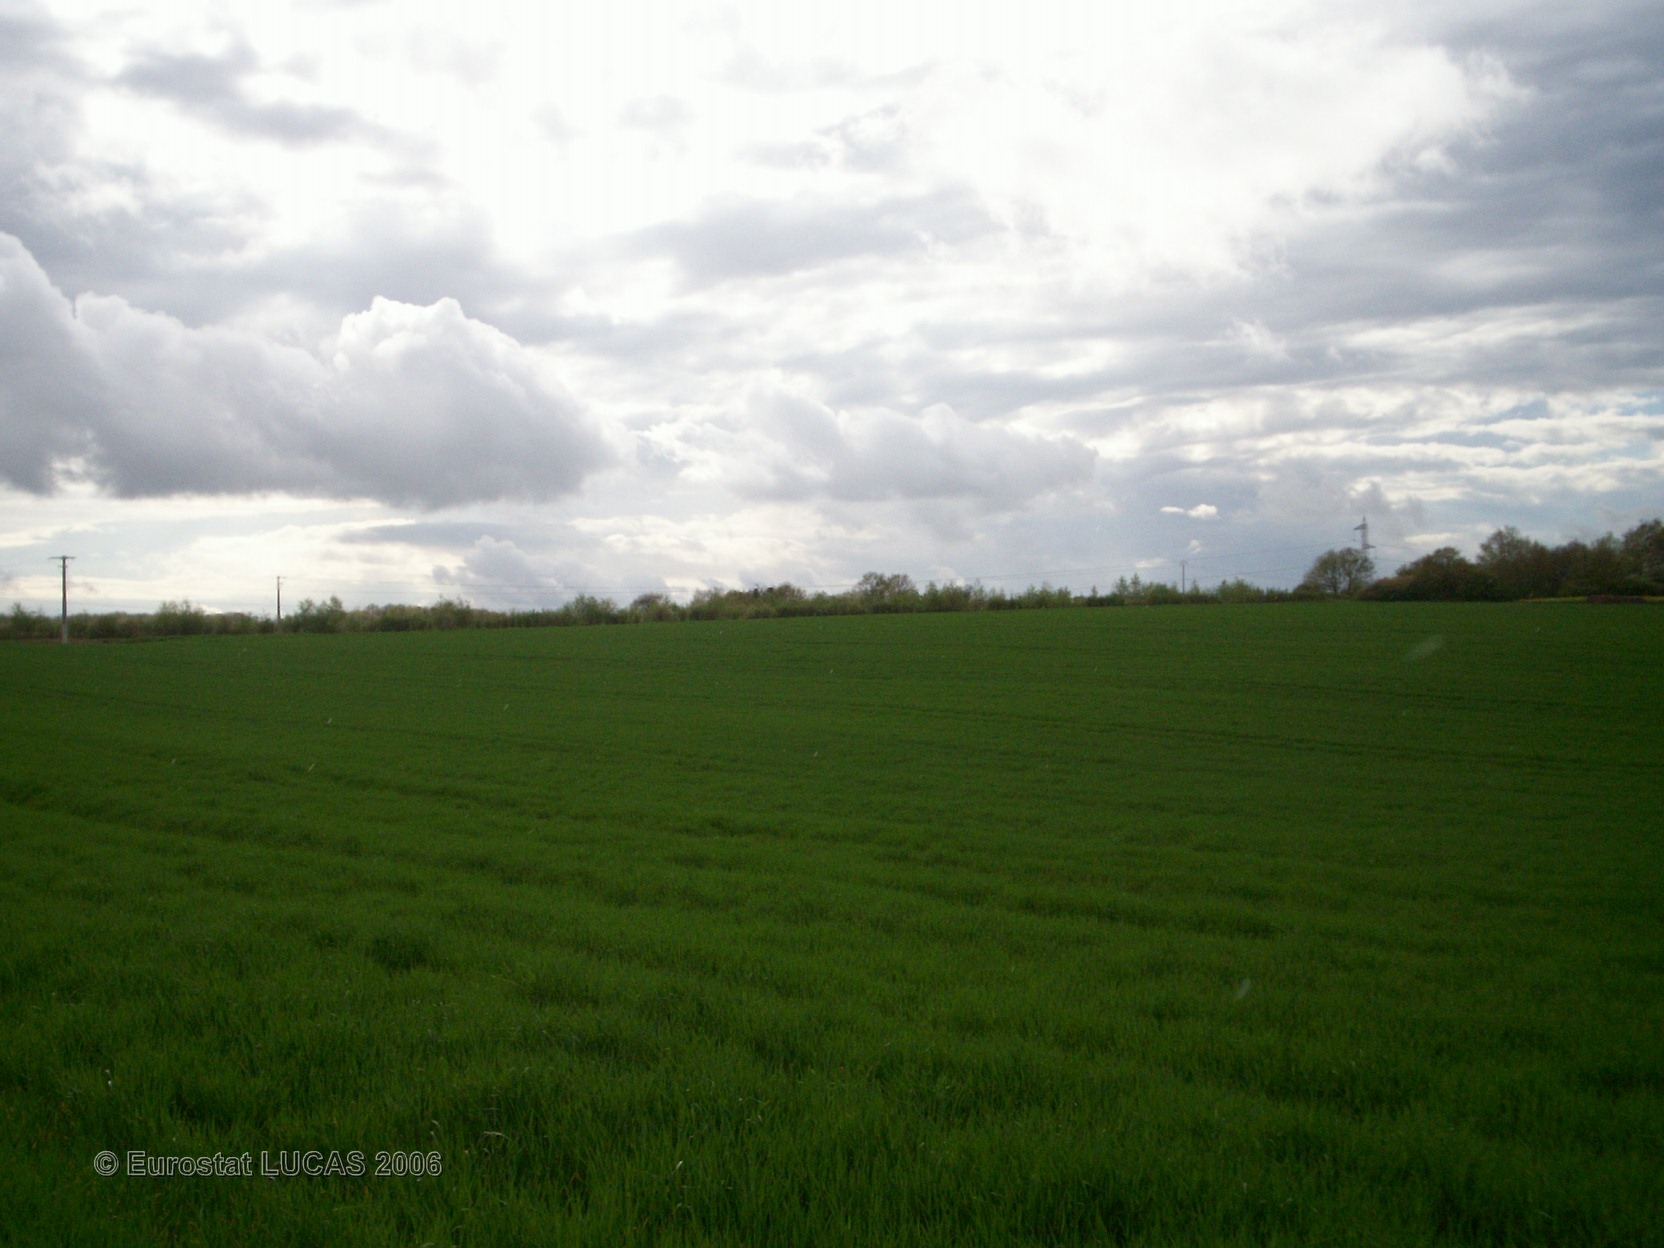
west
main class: Cropland
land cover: Barley
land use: Agriculture (excluding fallow land and kitchen gardens)
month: April
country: FR
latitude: 48.2863
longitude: 2.9435
